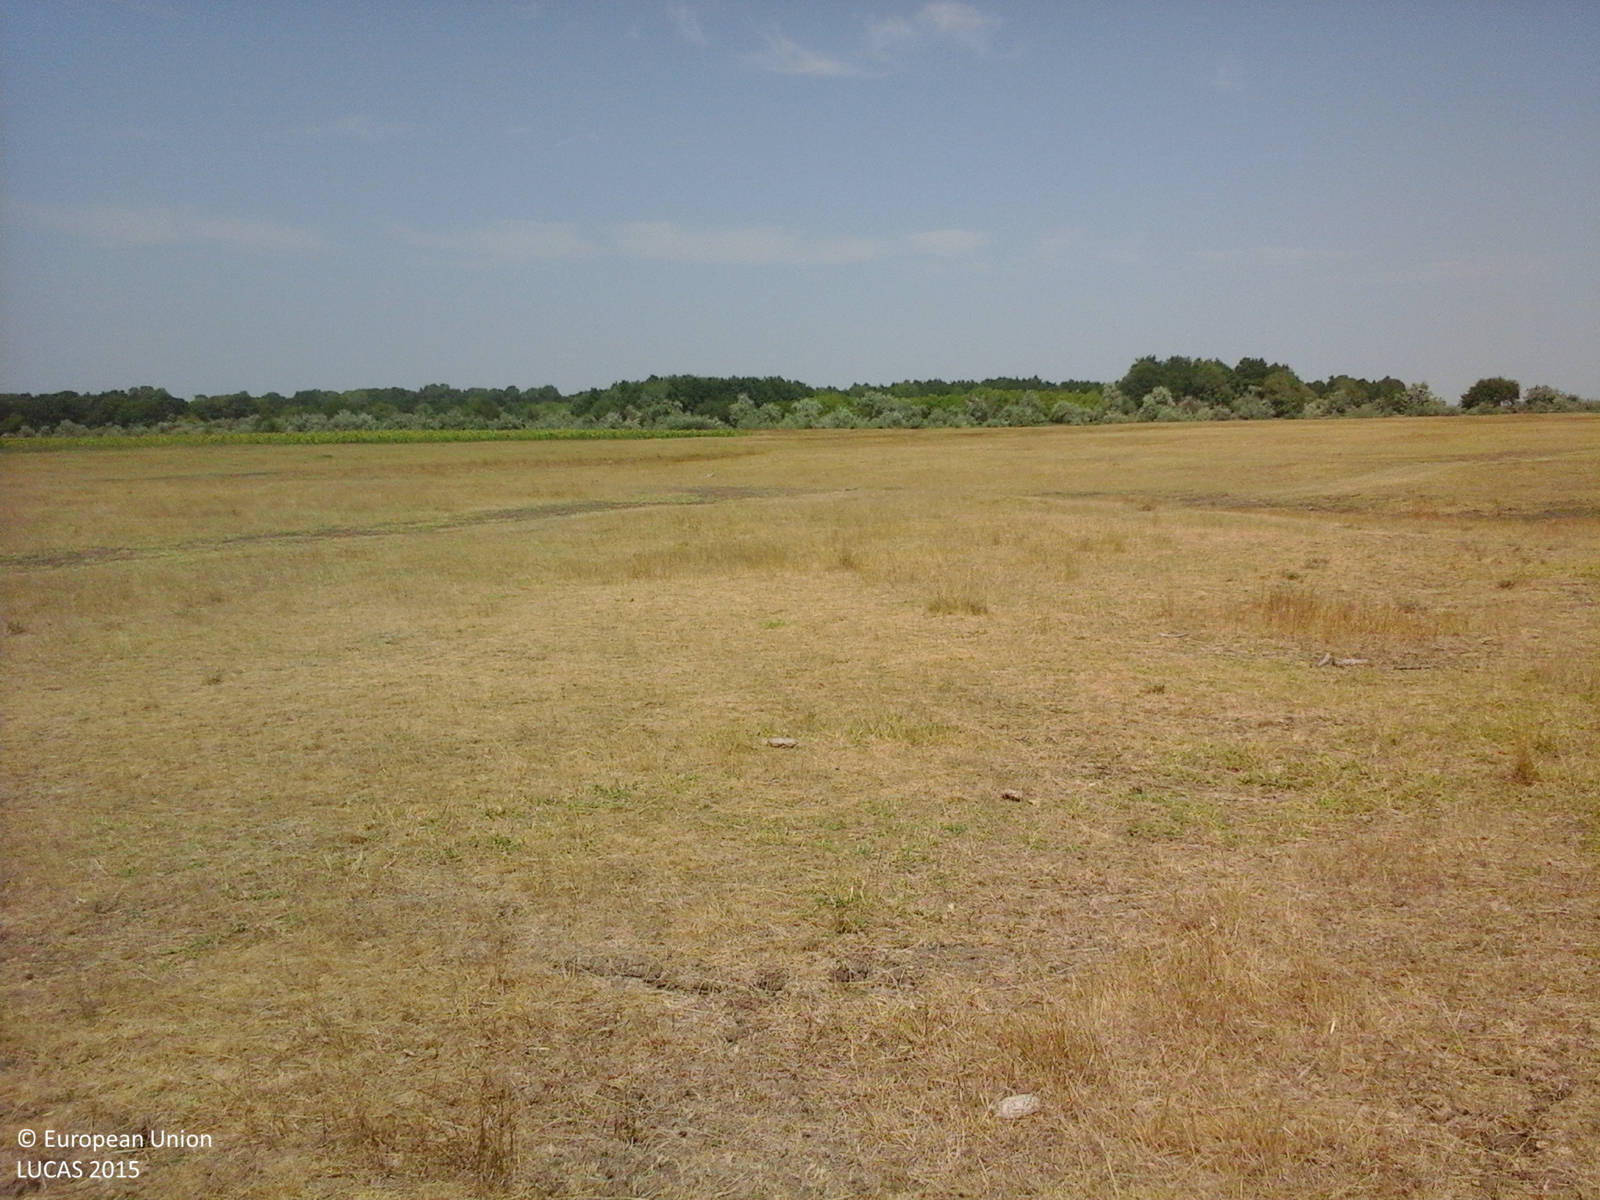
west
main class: Cropland
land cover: Temporary grasslands
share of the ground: > 75 %
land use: Agriculture (excluding fallow land and kitchen gardens)
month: August
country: RO
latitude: 45.7287
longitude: 27.4633
